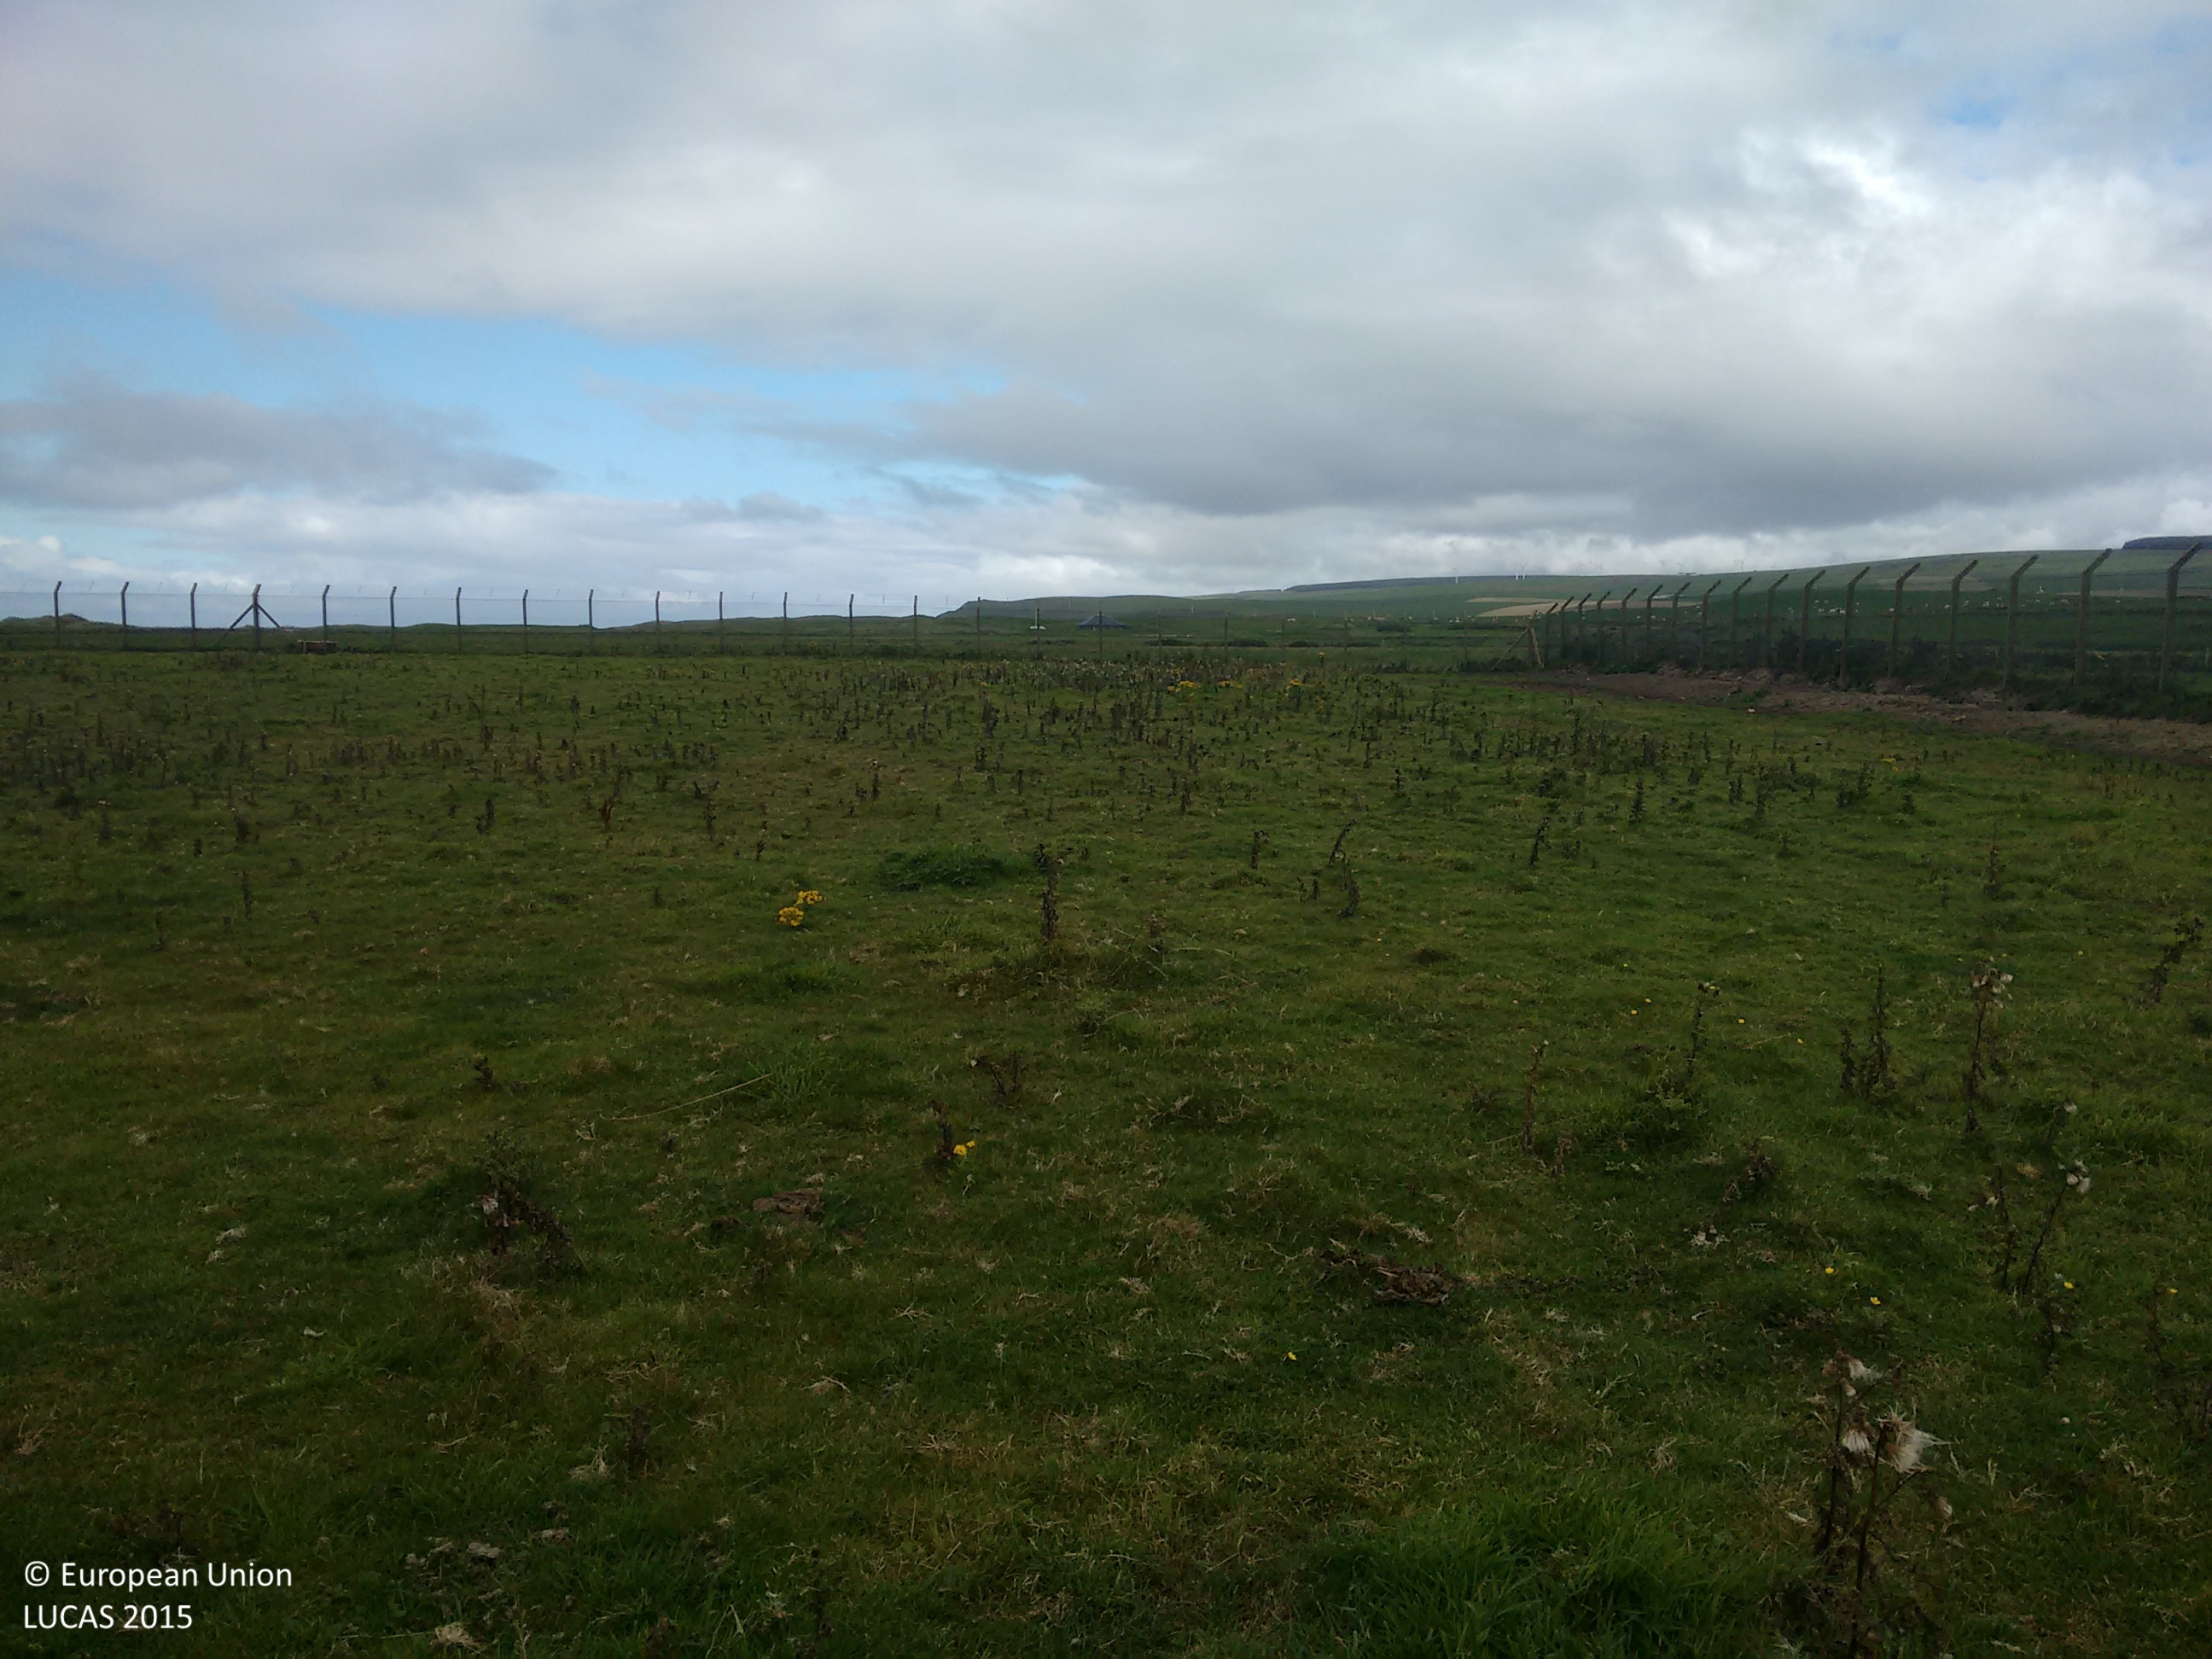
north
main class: Grassland
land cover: Grassland without tree/shrub cover
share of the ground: > 75 %
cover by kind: herbaceous plants 100 %
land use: Semi-natural and natural areas not in use
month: September
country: GB
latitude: 55.4505
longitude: -5.7036
